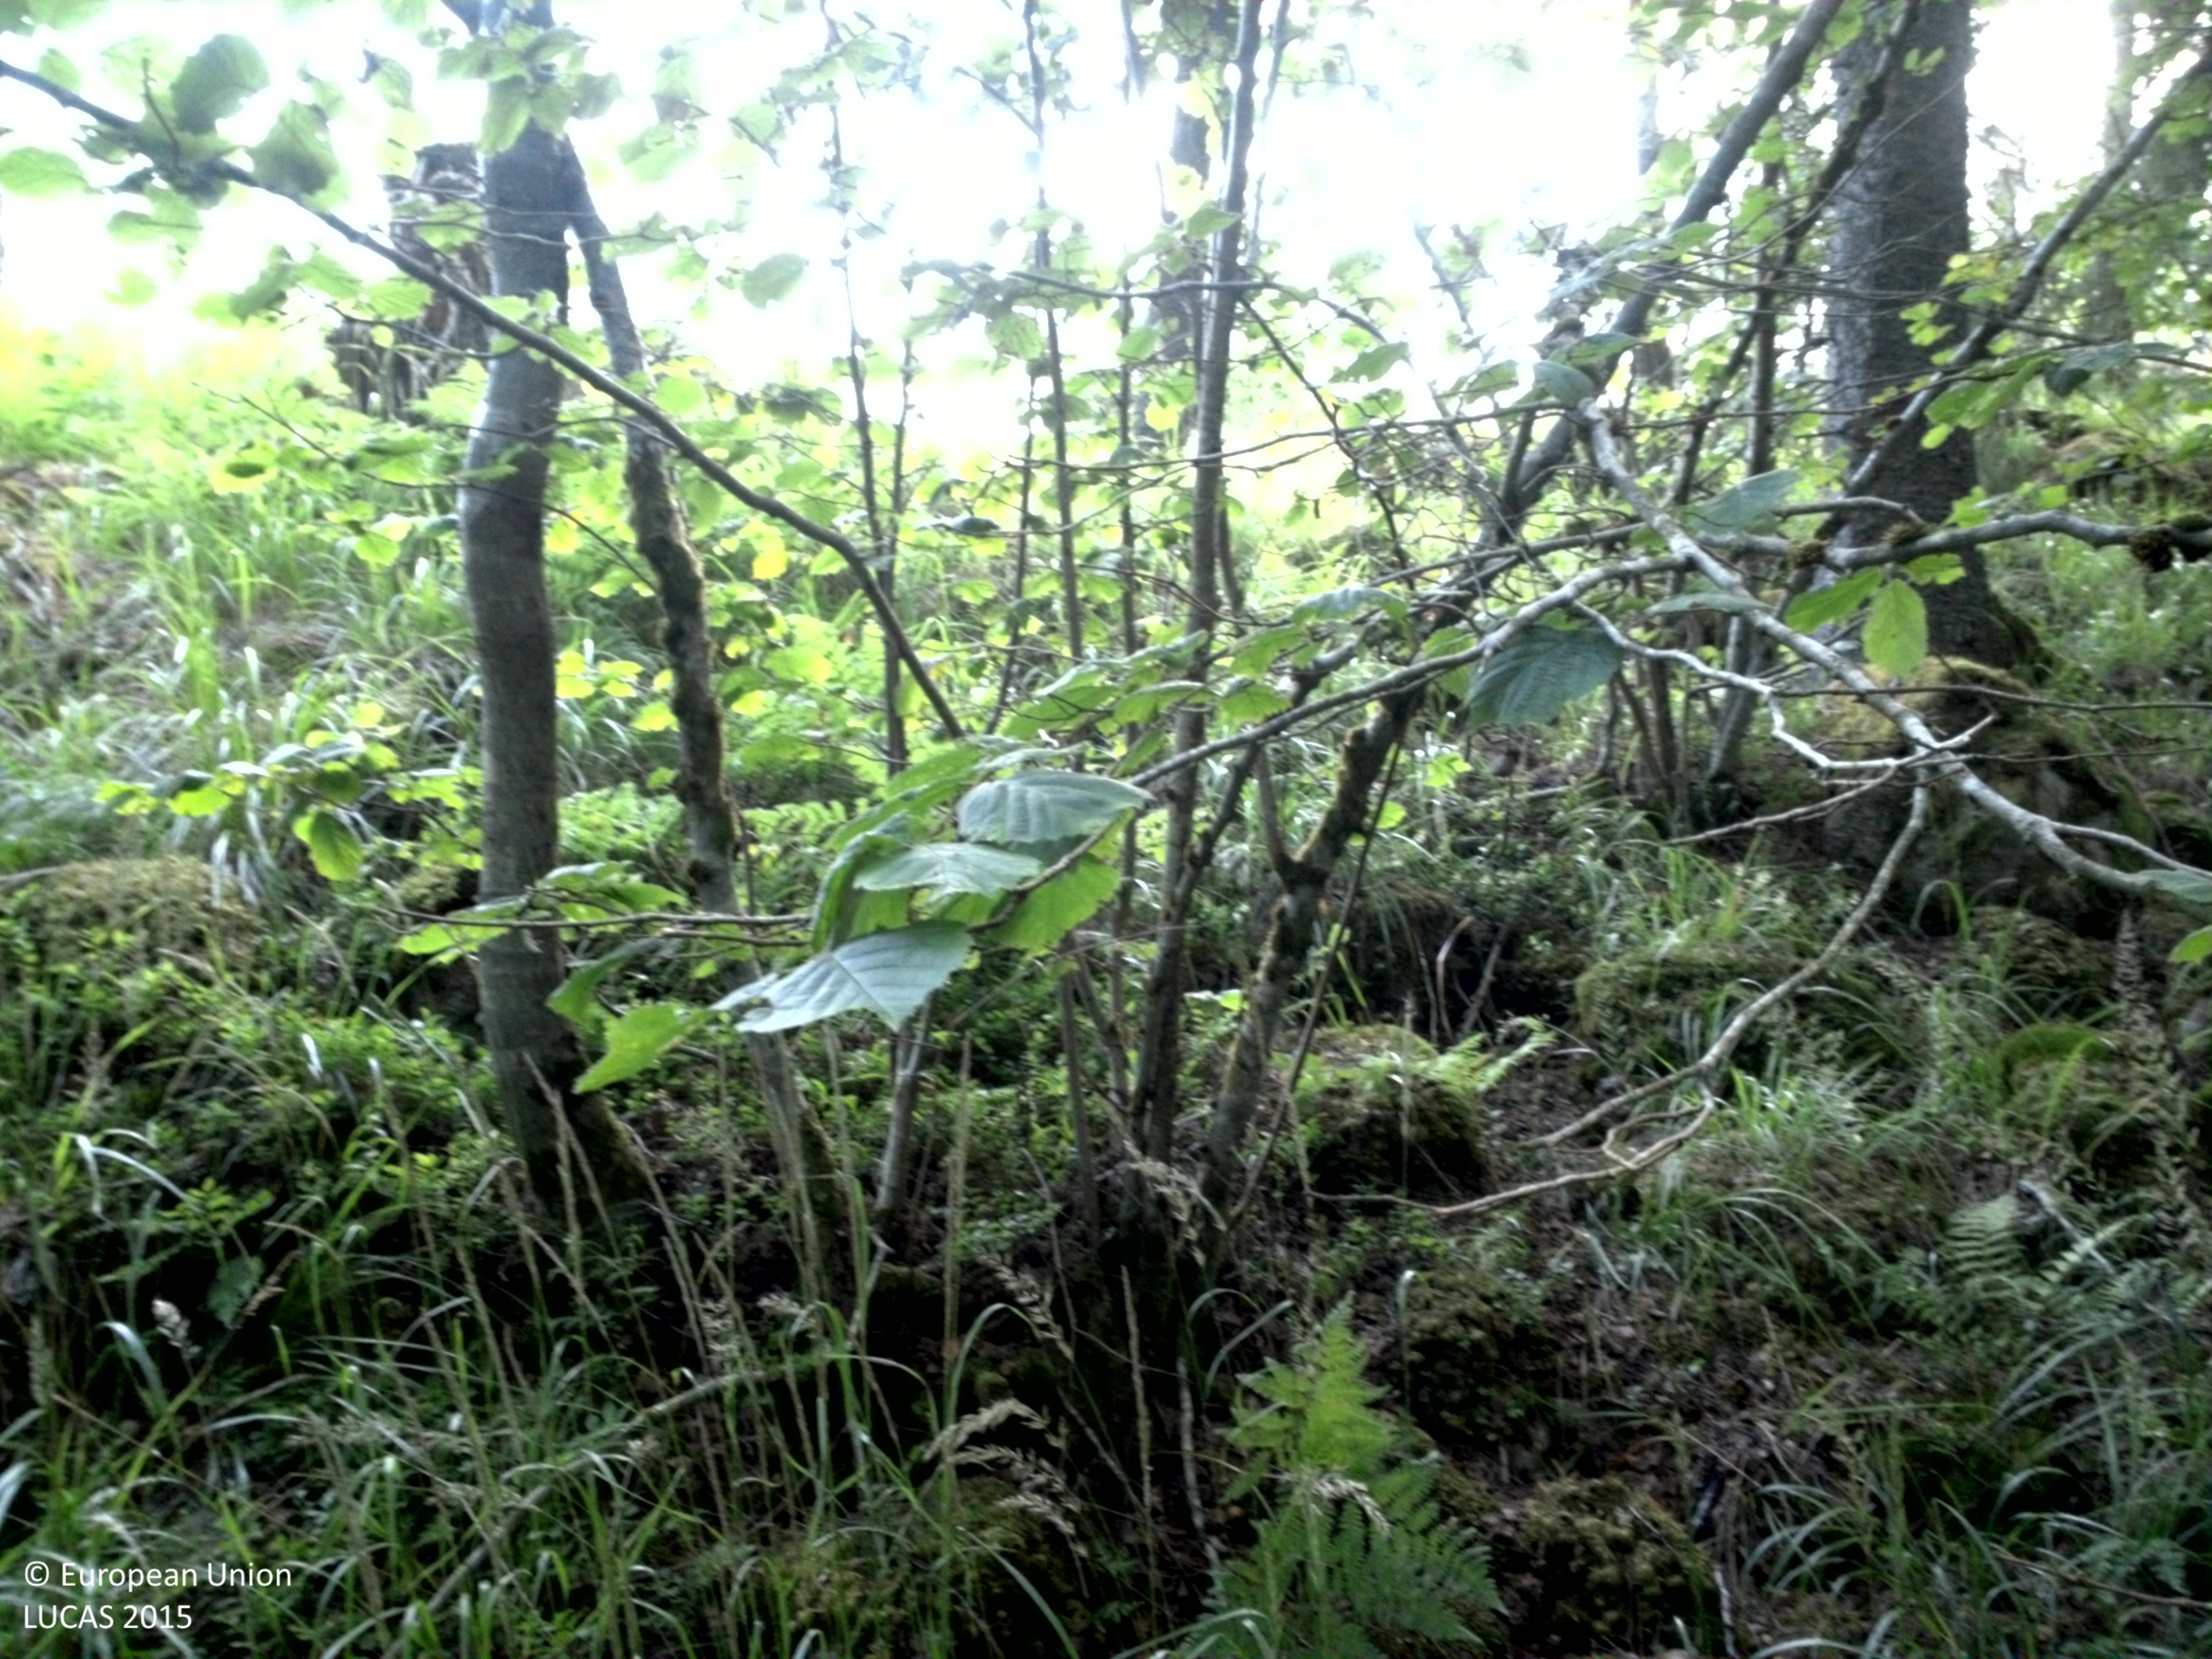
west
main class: Woodland
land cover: Spruce dominated mixed woodland
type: boreal forest
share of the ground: 50 - 75 %
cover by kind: coniferous forest trees 40 %, broadleaved forest trees 25 %, herbaceous plants 25 %, shrubs 10 %
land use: Forestry
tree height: > 5 m
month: July
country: SE
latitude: 58.5469
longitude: 14.3061
